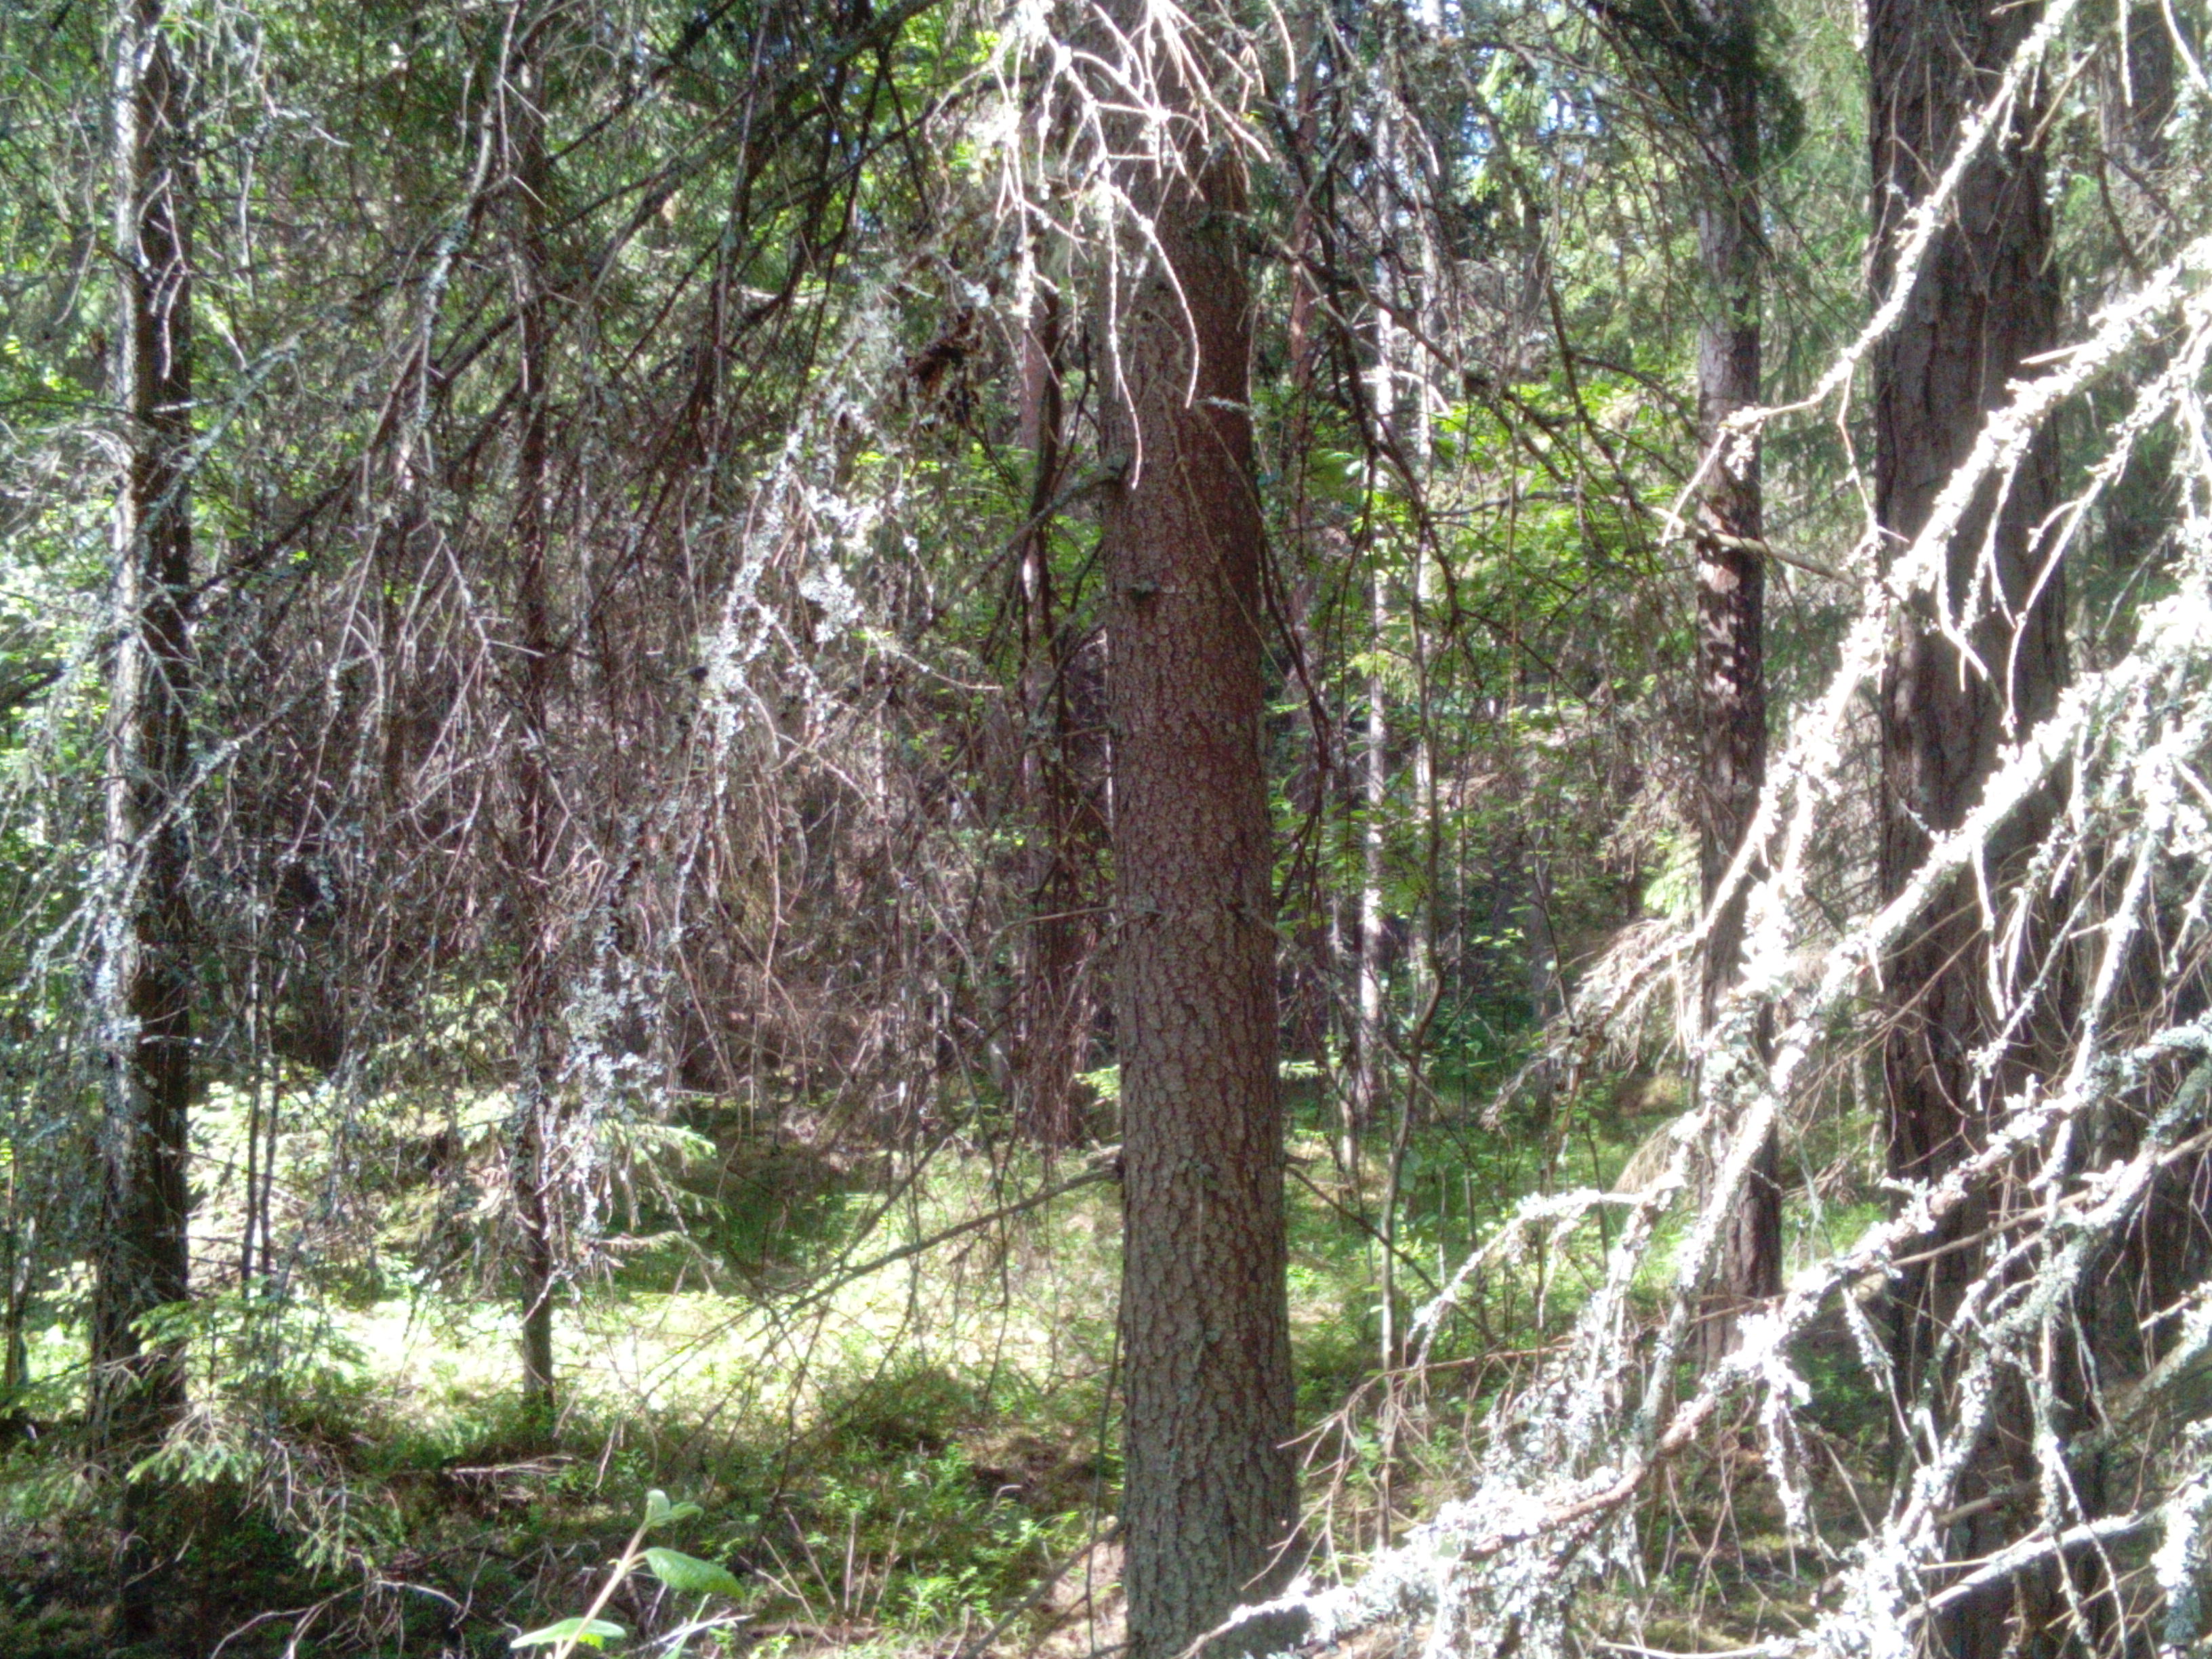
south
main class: Woodland
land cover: Other coniferous woodland
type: hemiboreal forest and nemoral coniferous forest and mixed broadleaved-coniferous forest
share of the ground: > 75 %
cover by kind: coniferous forest trees 75 %, herbaceous plants 10 %, lichens and mosses 10 %, broadleaved forest trees 5 %
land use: Forestry
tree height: > 5 m
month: June
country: LV
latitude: 56.8506
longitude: 22.1013
